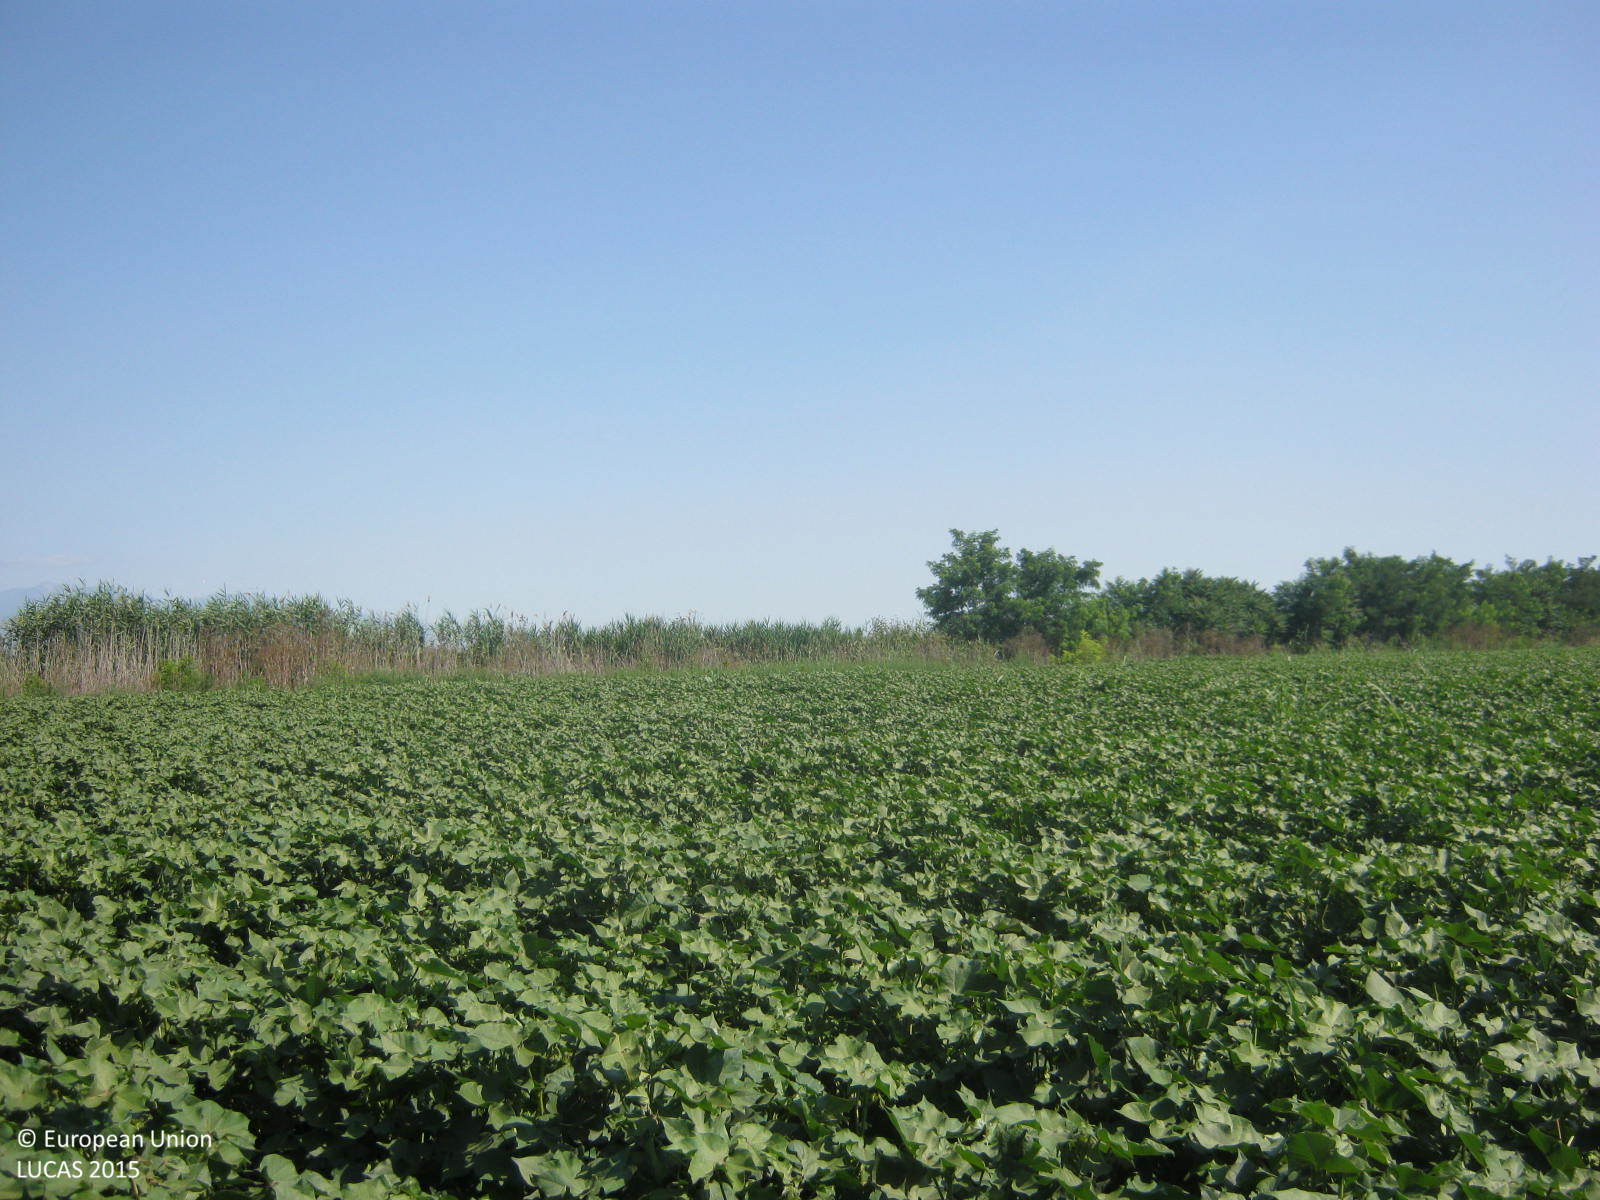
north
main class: Cropland
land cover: Cotton
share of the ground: > 75 %
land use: Agriculture (excluding fallow land and kitchen gardens)
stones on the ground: < 10 %
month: July
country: GR
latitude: 40.6850
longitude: 22.5336
